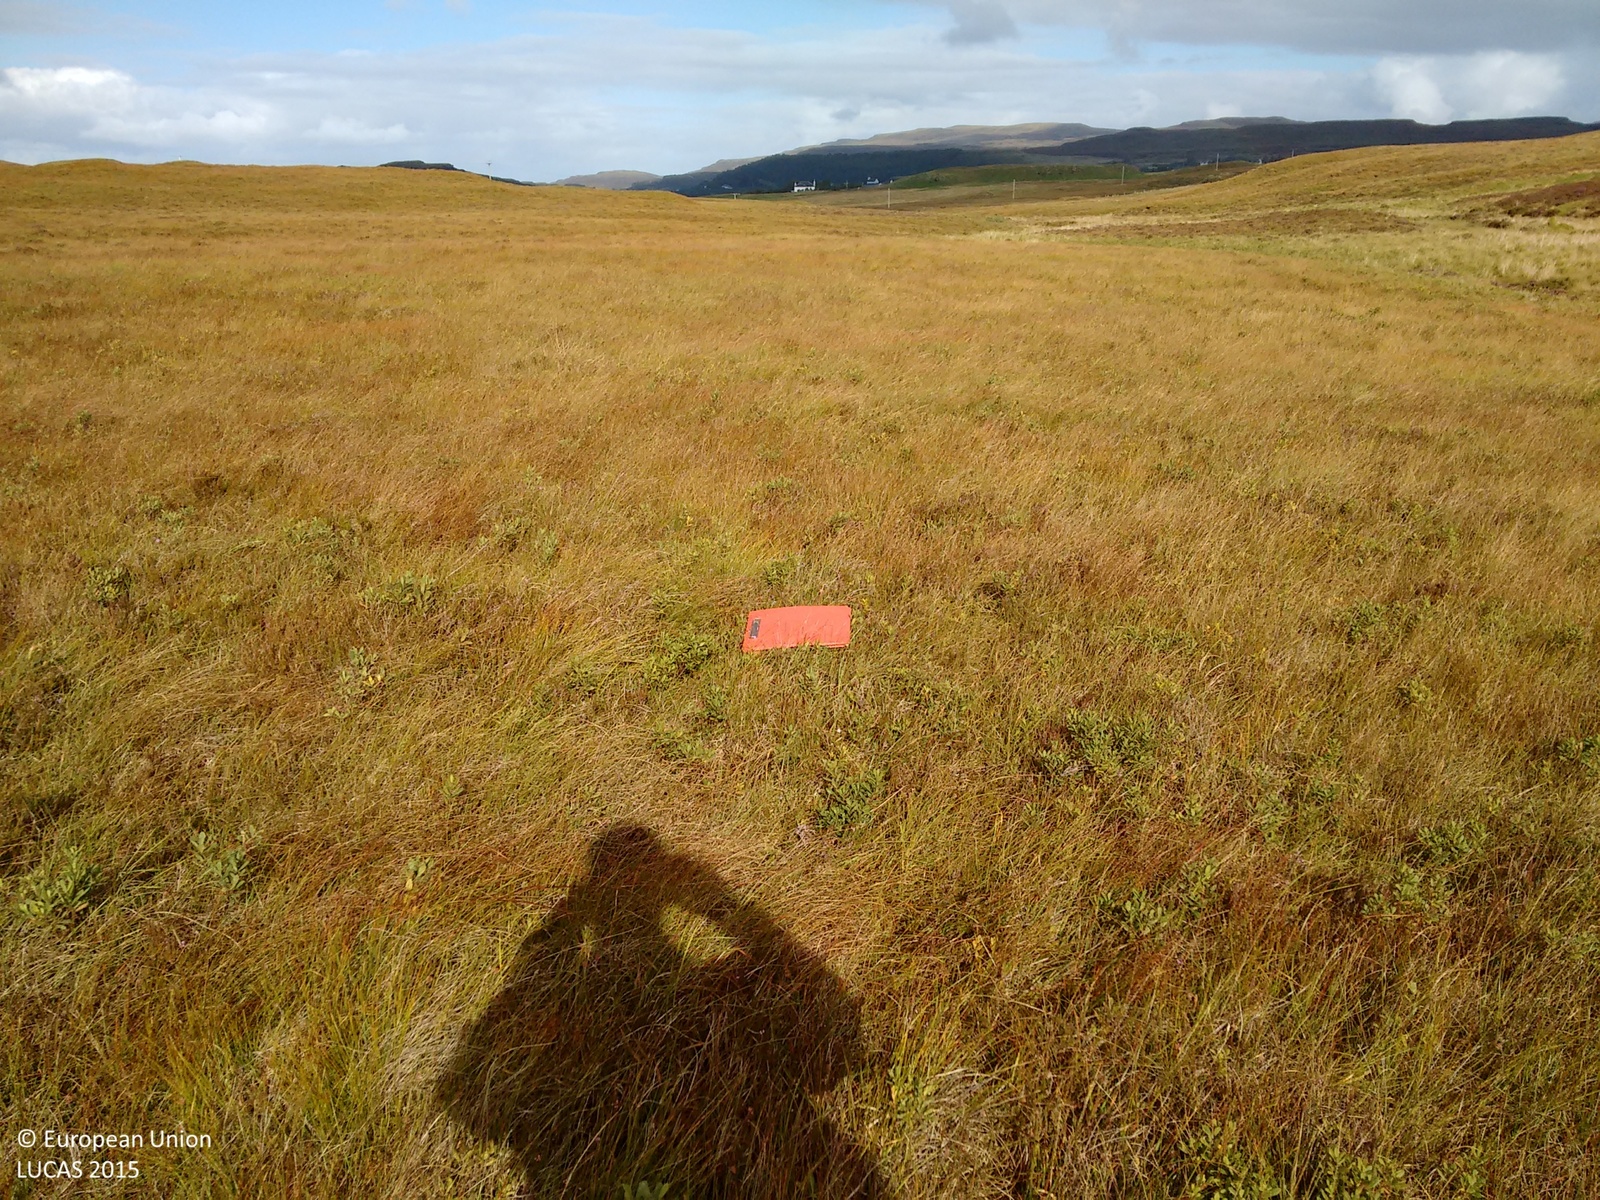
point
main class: Shrubland
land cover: Shrubland without tree cover
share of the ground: > 75 %
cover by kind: shrubs 75 %, herbaceous plants 25 %
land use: Agriculture (excluding fallow land and kitchen gardens)
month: September
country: GB
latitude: 57.4180
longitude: -6.5788
